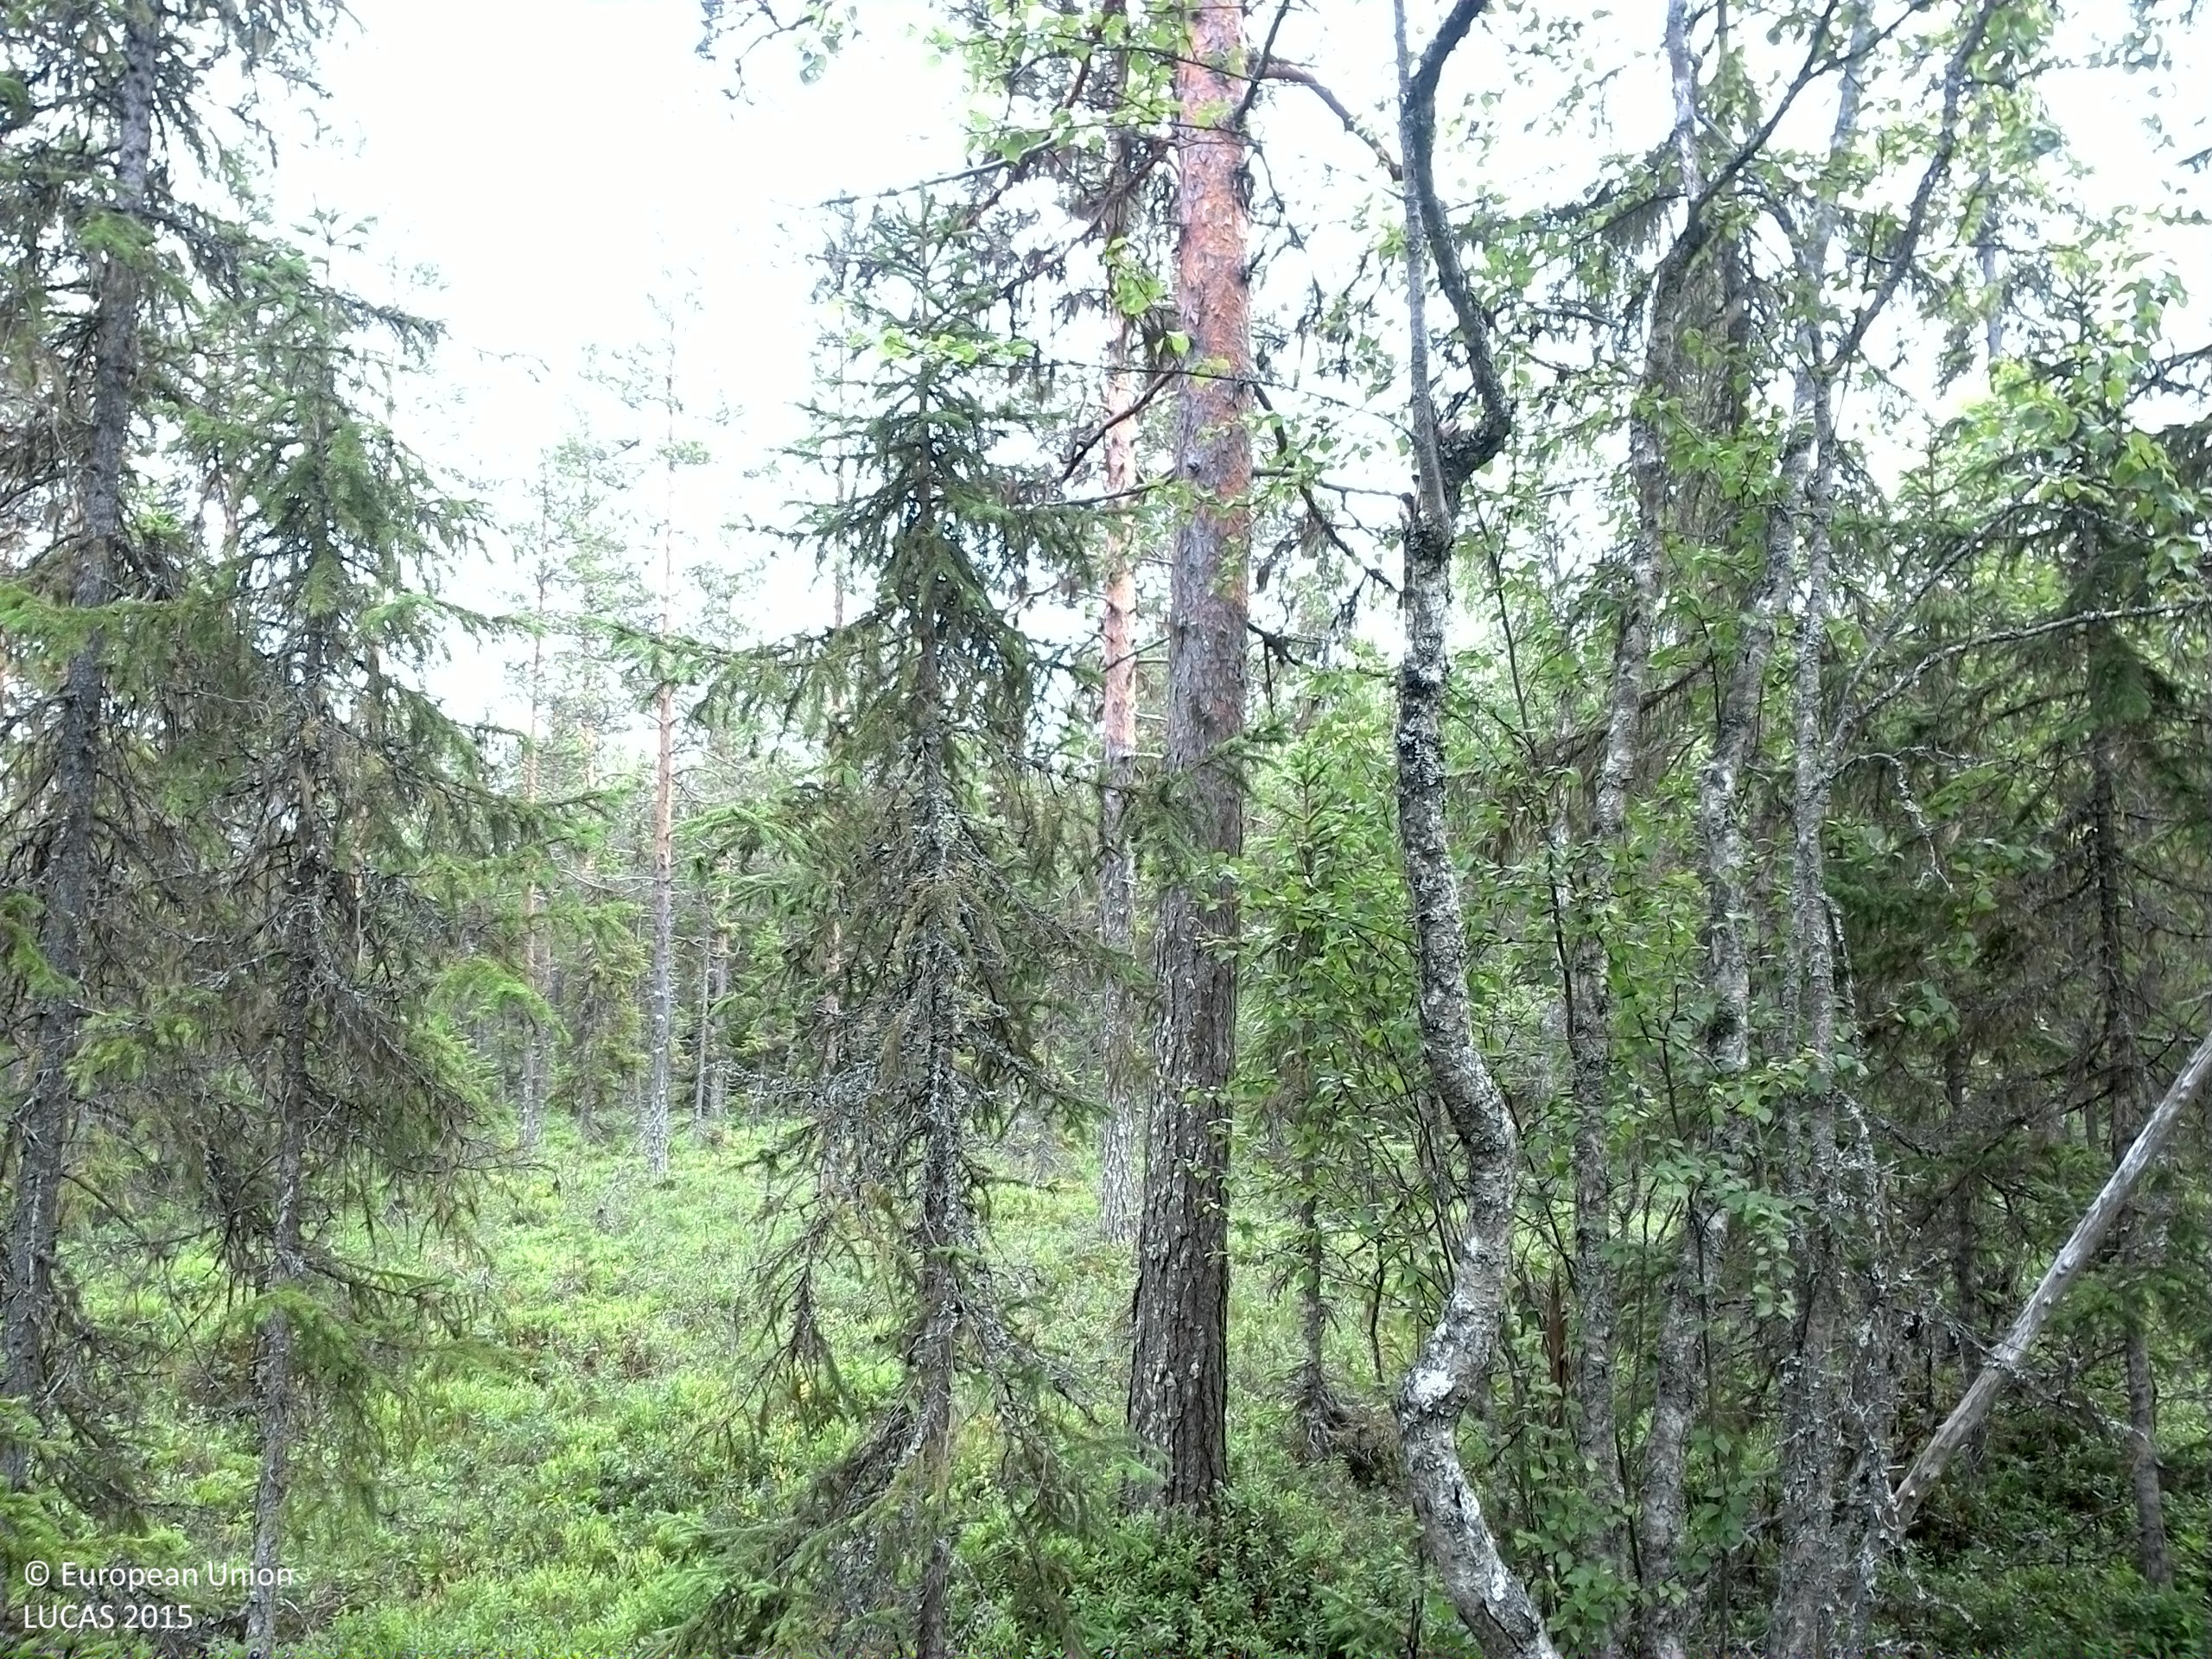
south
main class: Woodland
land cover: Pine dominated coniferous woodland
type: boreal forest
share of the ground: 25 - 50 %
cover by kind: shrubs 50 %, coniferous forest trees 35 %, broadleaved forest trees 5 %, herbaceous plants 5 %, lichens and mosses 5 %
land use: Forestry
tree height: > 5 m
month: July
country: SE
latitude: 62.8341
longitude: 16.9078
